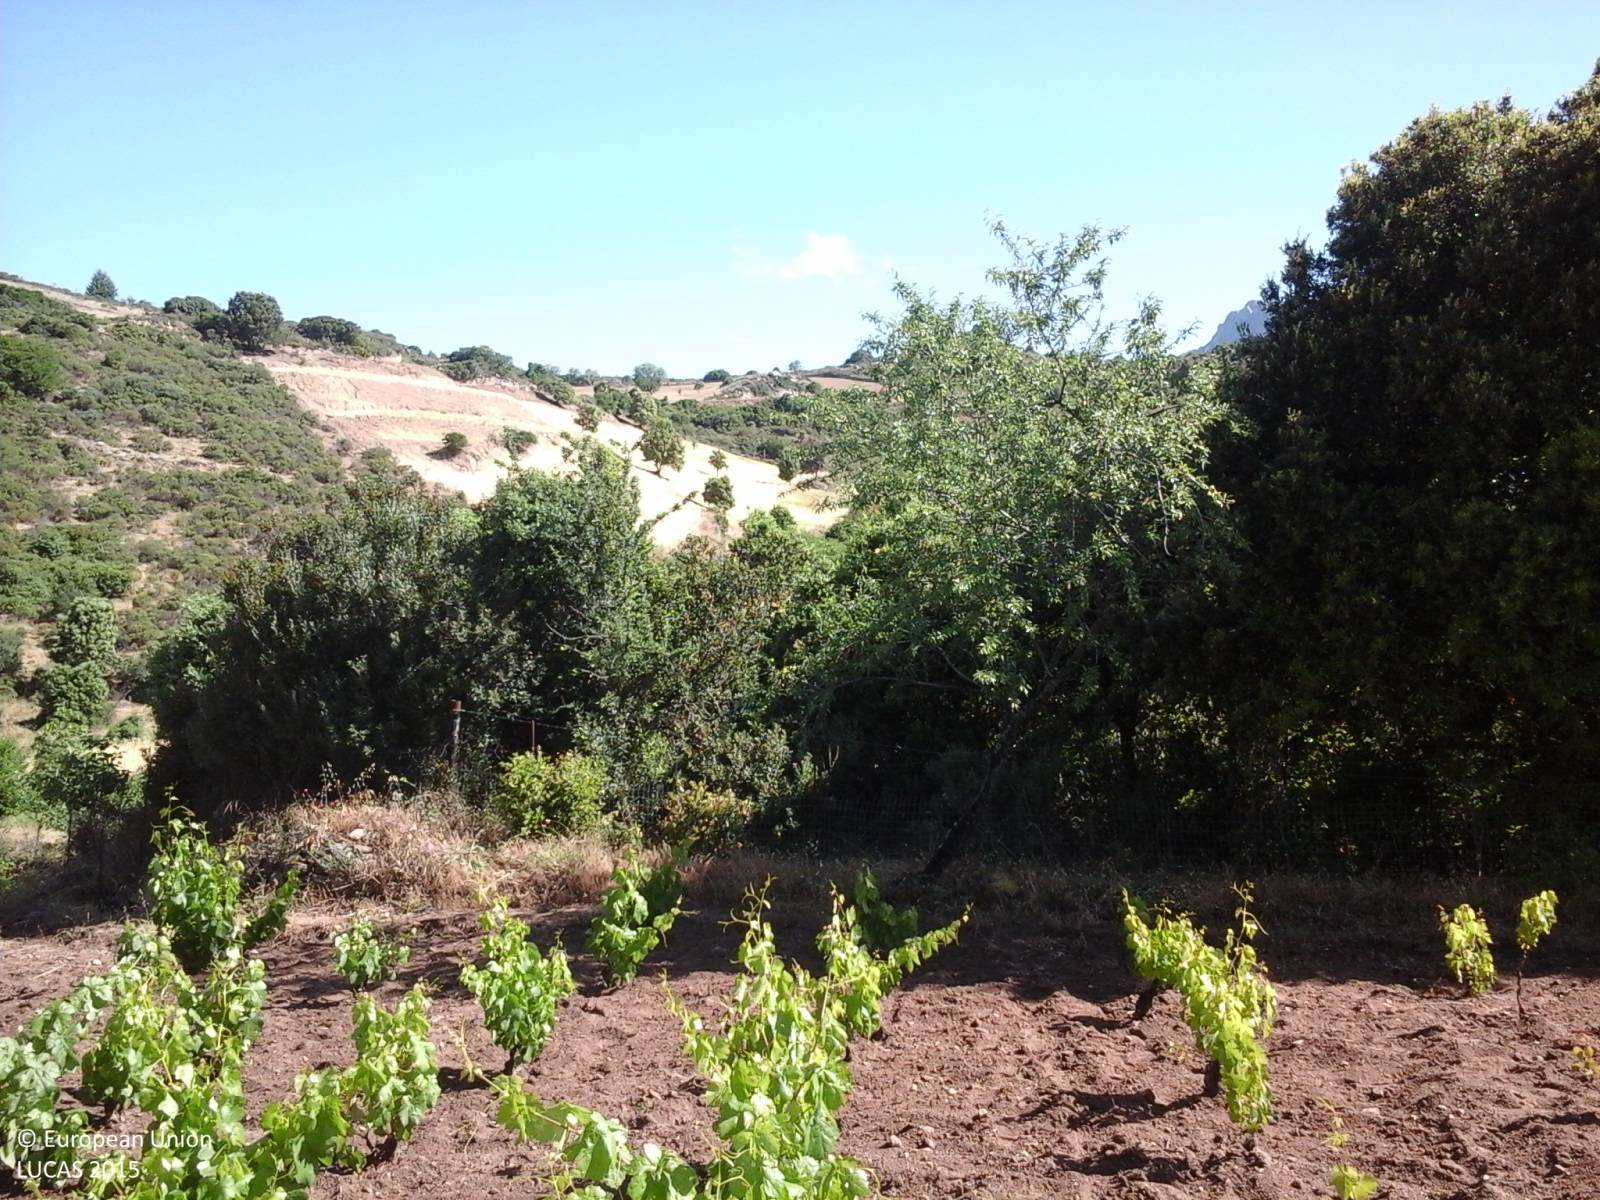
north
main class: Cropland
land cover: Vineyards
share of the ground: 50 - 75 %
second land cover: Other bare soil
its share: > 75 %
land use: Agriculture (excluding fallow land and kitchen gardens)
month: May
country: IT
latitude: 40.2293
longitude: 9.4038
